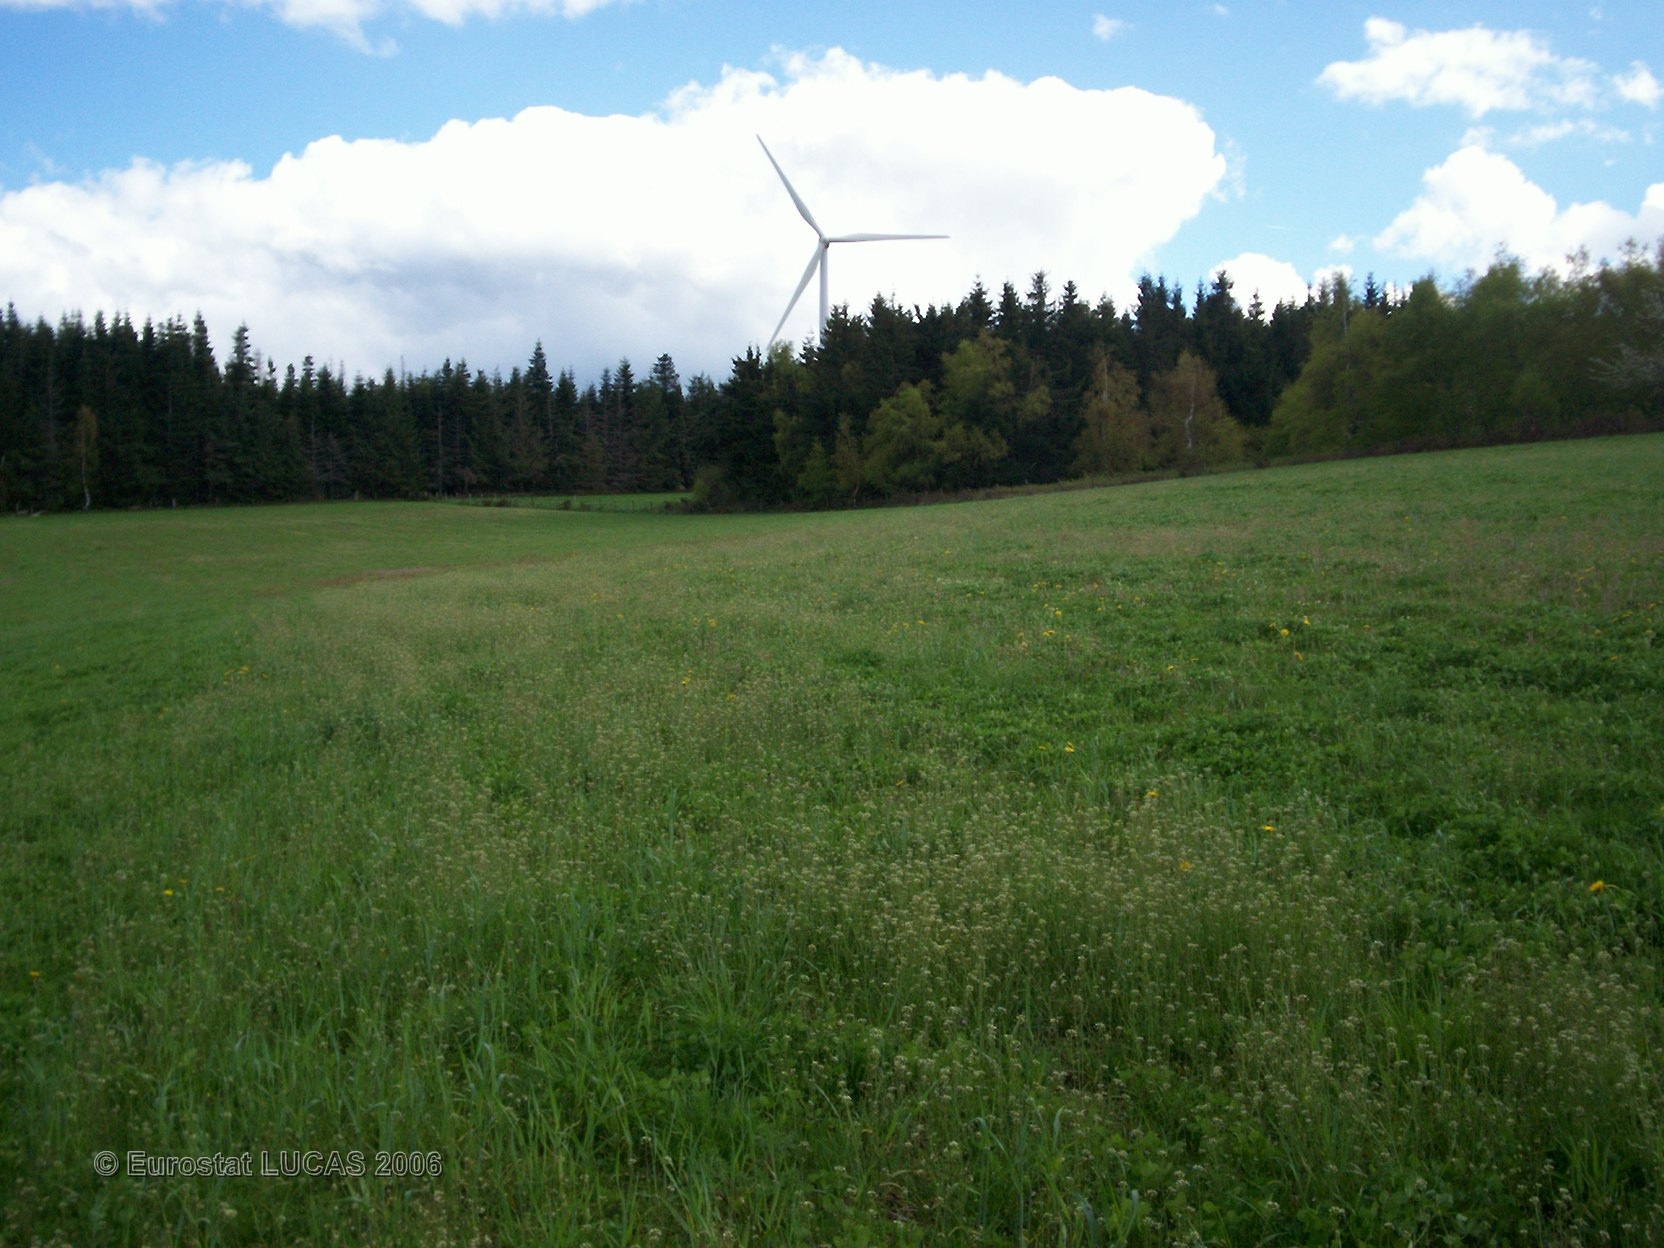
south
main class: Grassland
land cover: Grassland without tree/shrub cover
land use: Agriculture (excluding fallow land and kitchen gardens)
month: May
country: FR
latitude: 45.1468
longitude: 3.2999
